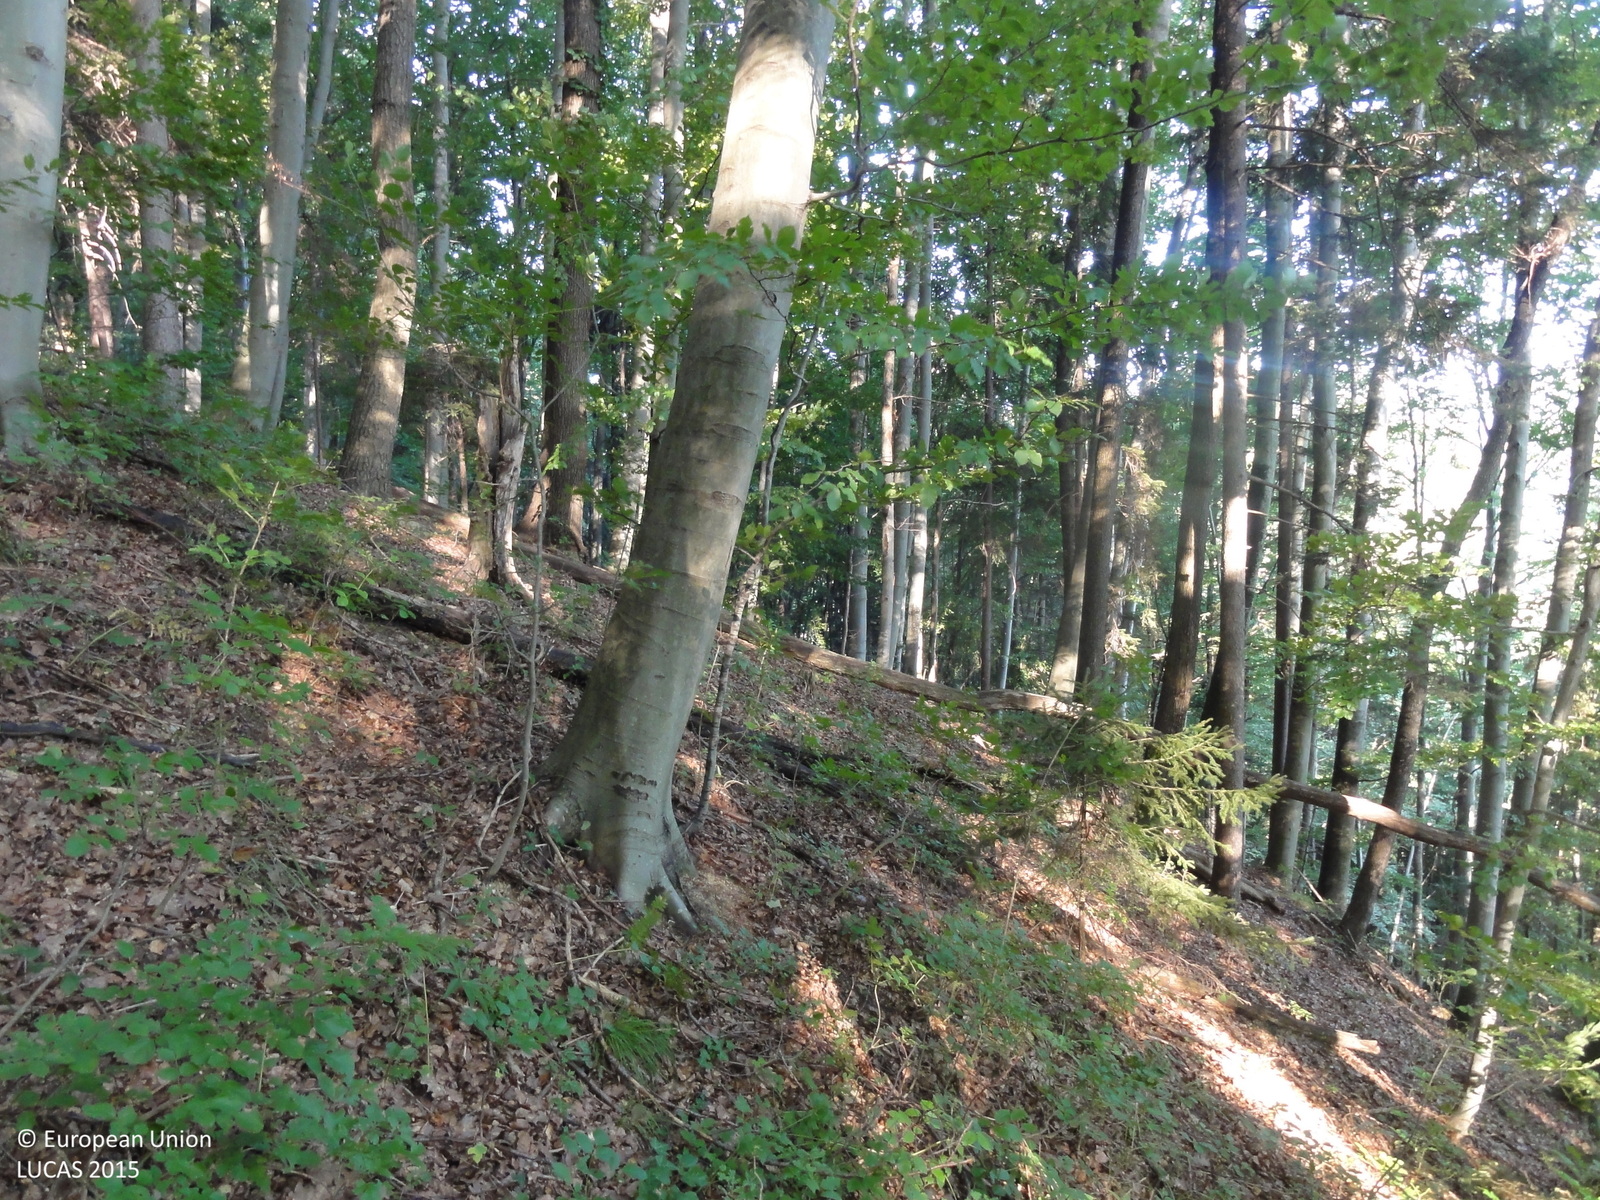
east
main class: Woodland
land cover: Broadleaved woodland
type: beech forest
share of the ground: > 75 %
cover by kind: broadleaved forest trees 95 %, coniferous forest trees 5 %
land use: Forestry
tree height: > 5 m
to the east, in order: Broadleaved woodland; Tracks; Broadleaved woodland; Shrubland with sparse tree cover
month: August
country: SI
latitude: 46.0657
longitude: 15.1294
